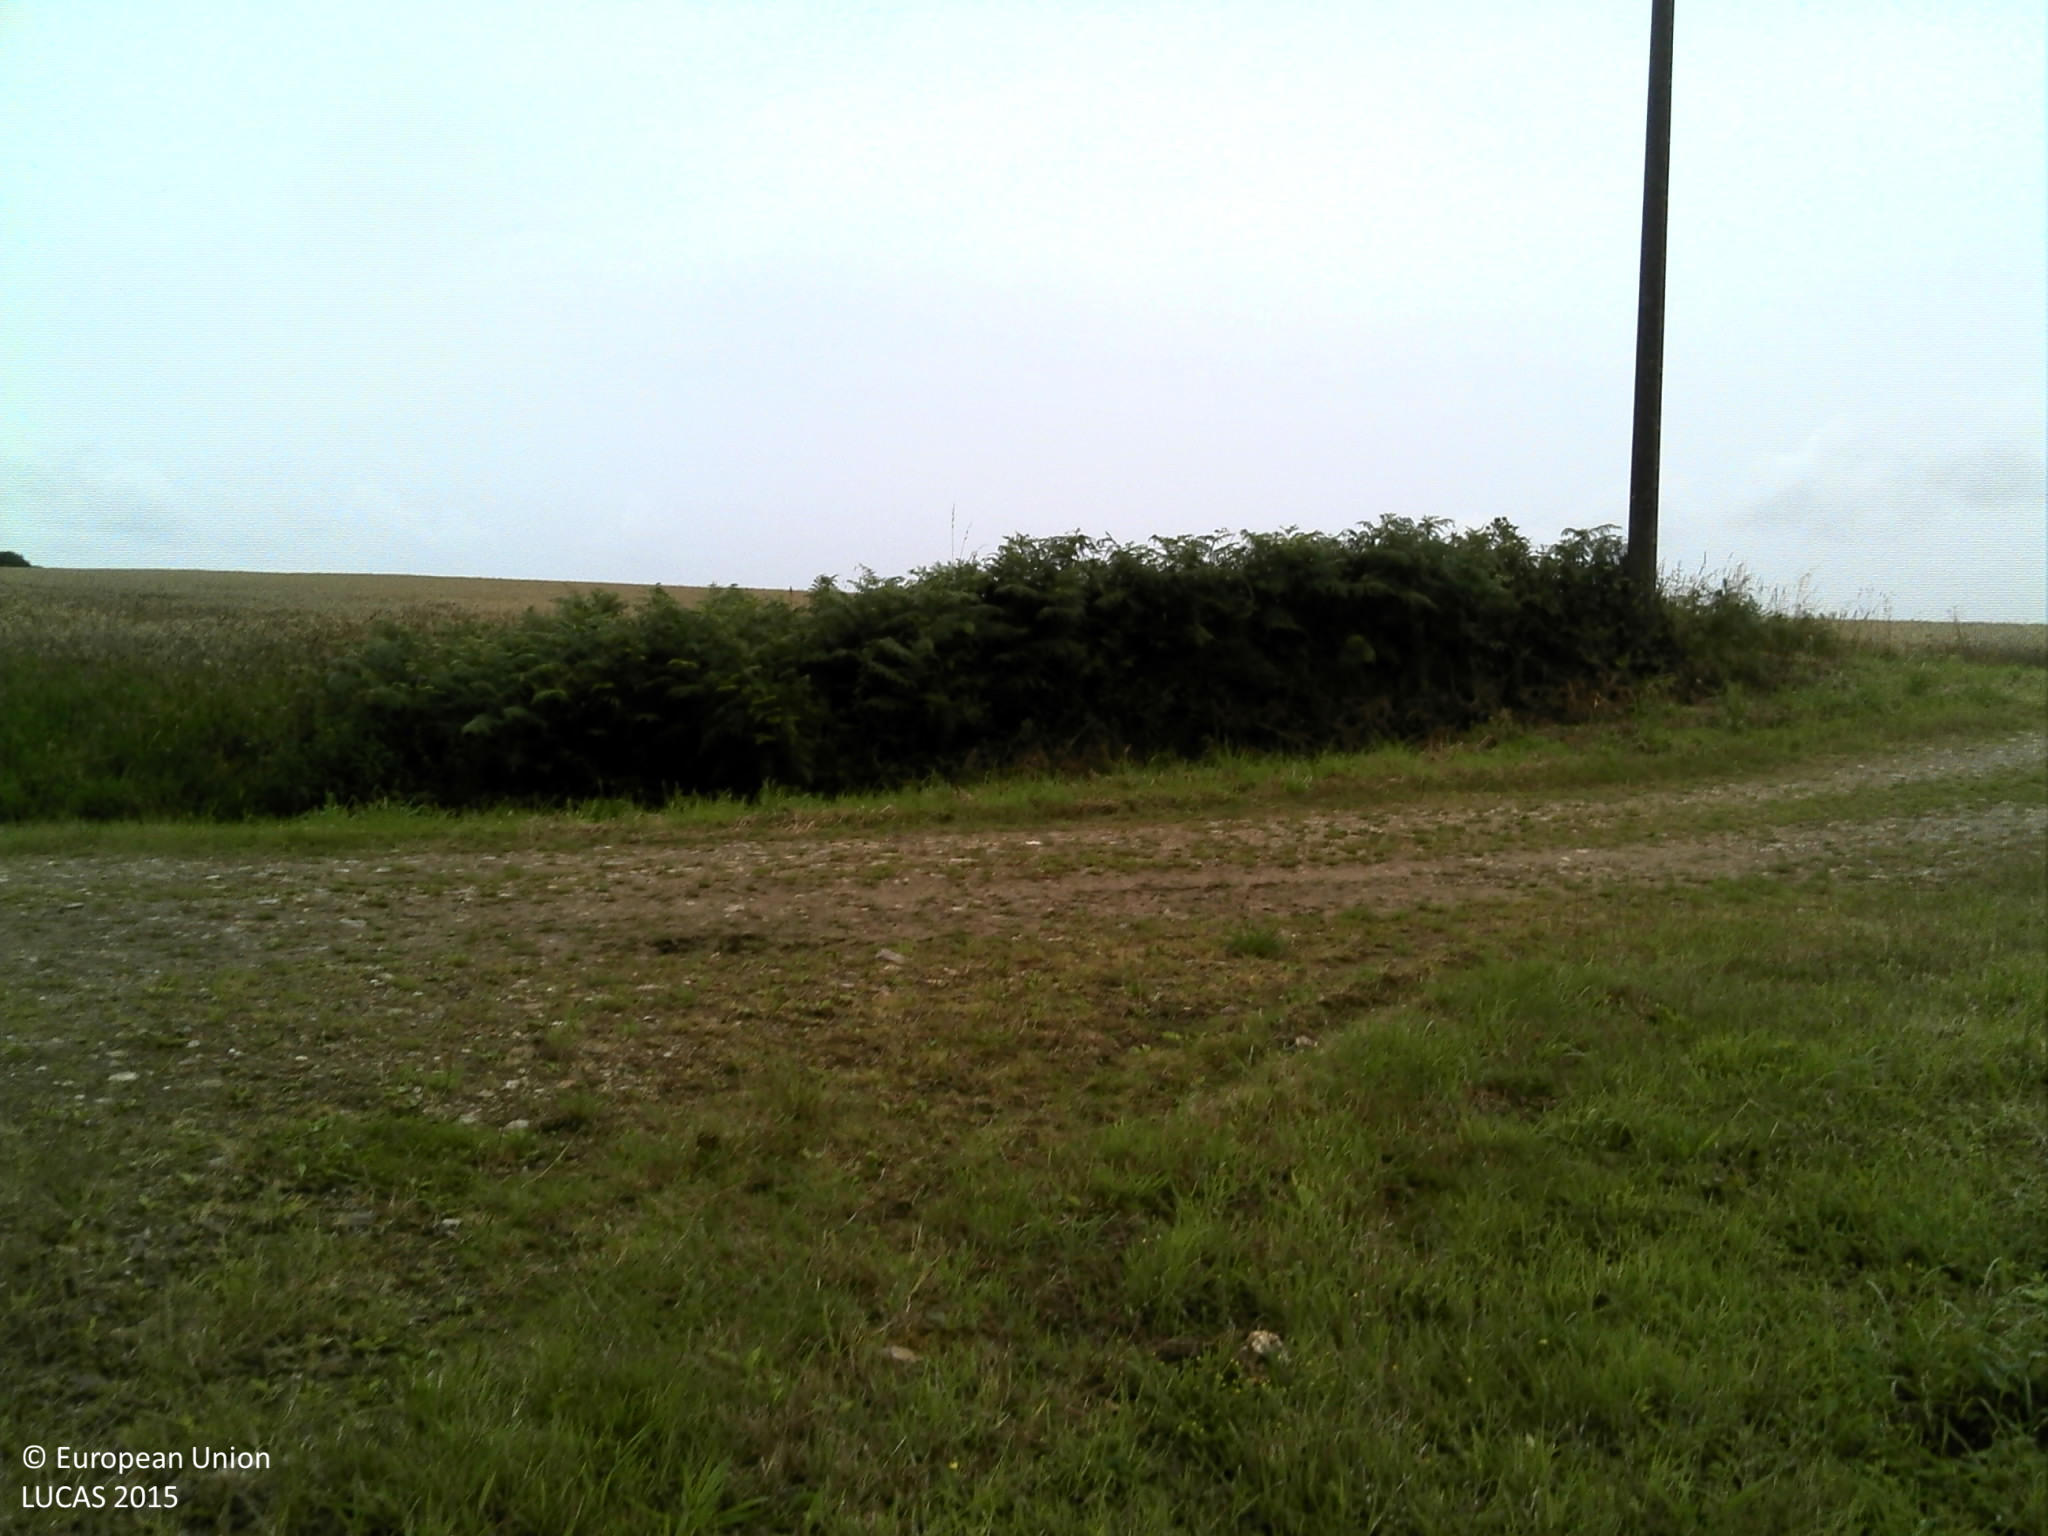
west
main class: Grassland
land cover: Grassland without tree/shrub cover
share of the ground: > 75 %
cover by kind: herbaceous plants 100 %
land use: Road transport
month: July
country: FR
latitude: 48.3551
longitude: -4.2221
